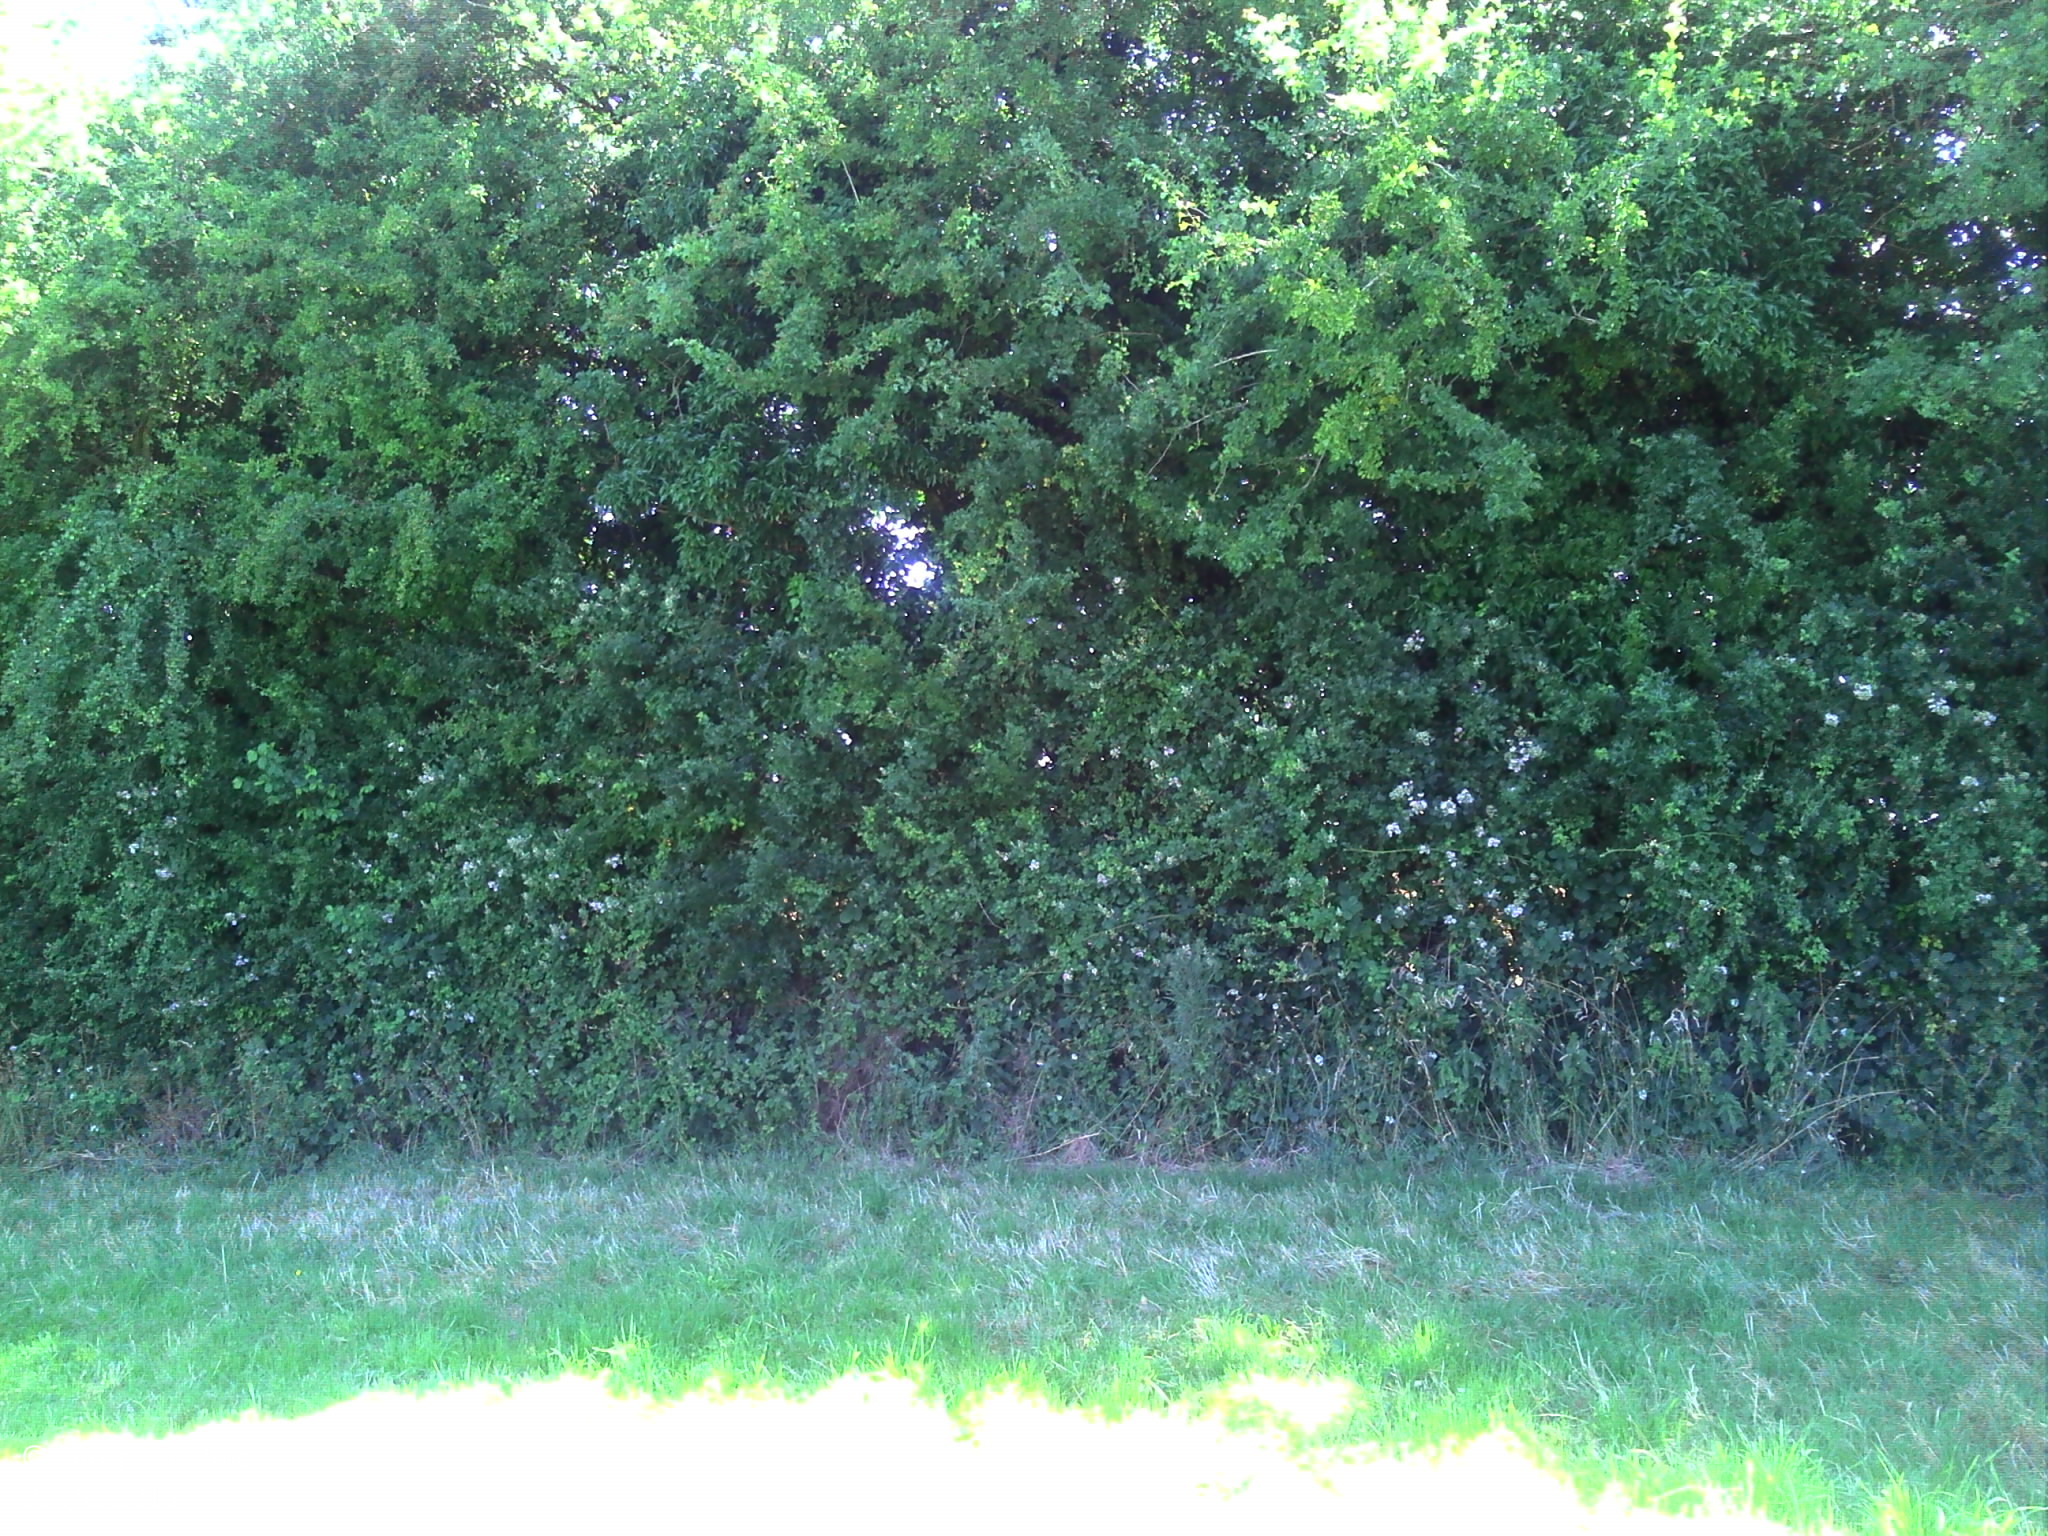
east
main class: Grassland
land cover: Grassland without tree/shrub cover
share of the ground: > 75 %
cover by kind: herbaceous plants 100 %
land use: Agriculture (excluding fallow land and kitchen gardens)
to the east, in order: Grassland without tree/shrub cover; Abandoned hedges; Fences; Grassland without tree/shrub cover; Fences; Grassland without tree/shrub cover; Abandoned hedges; Fences; Maize
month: July
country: FR
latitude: 49.0521
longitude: 0.3810
